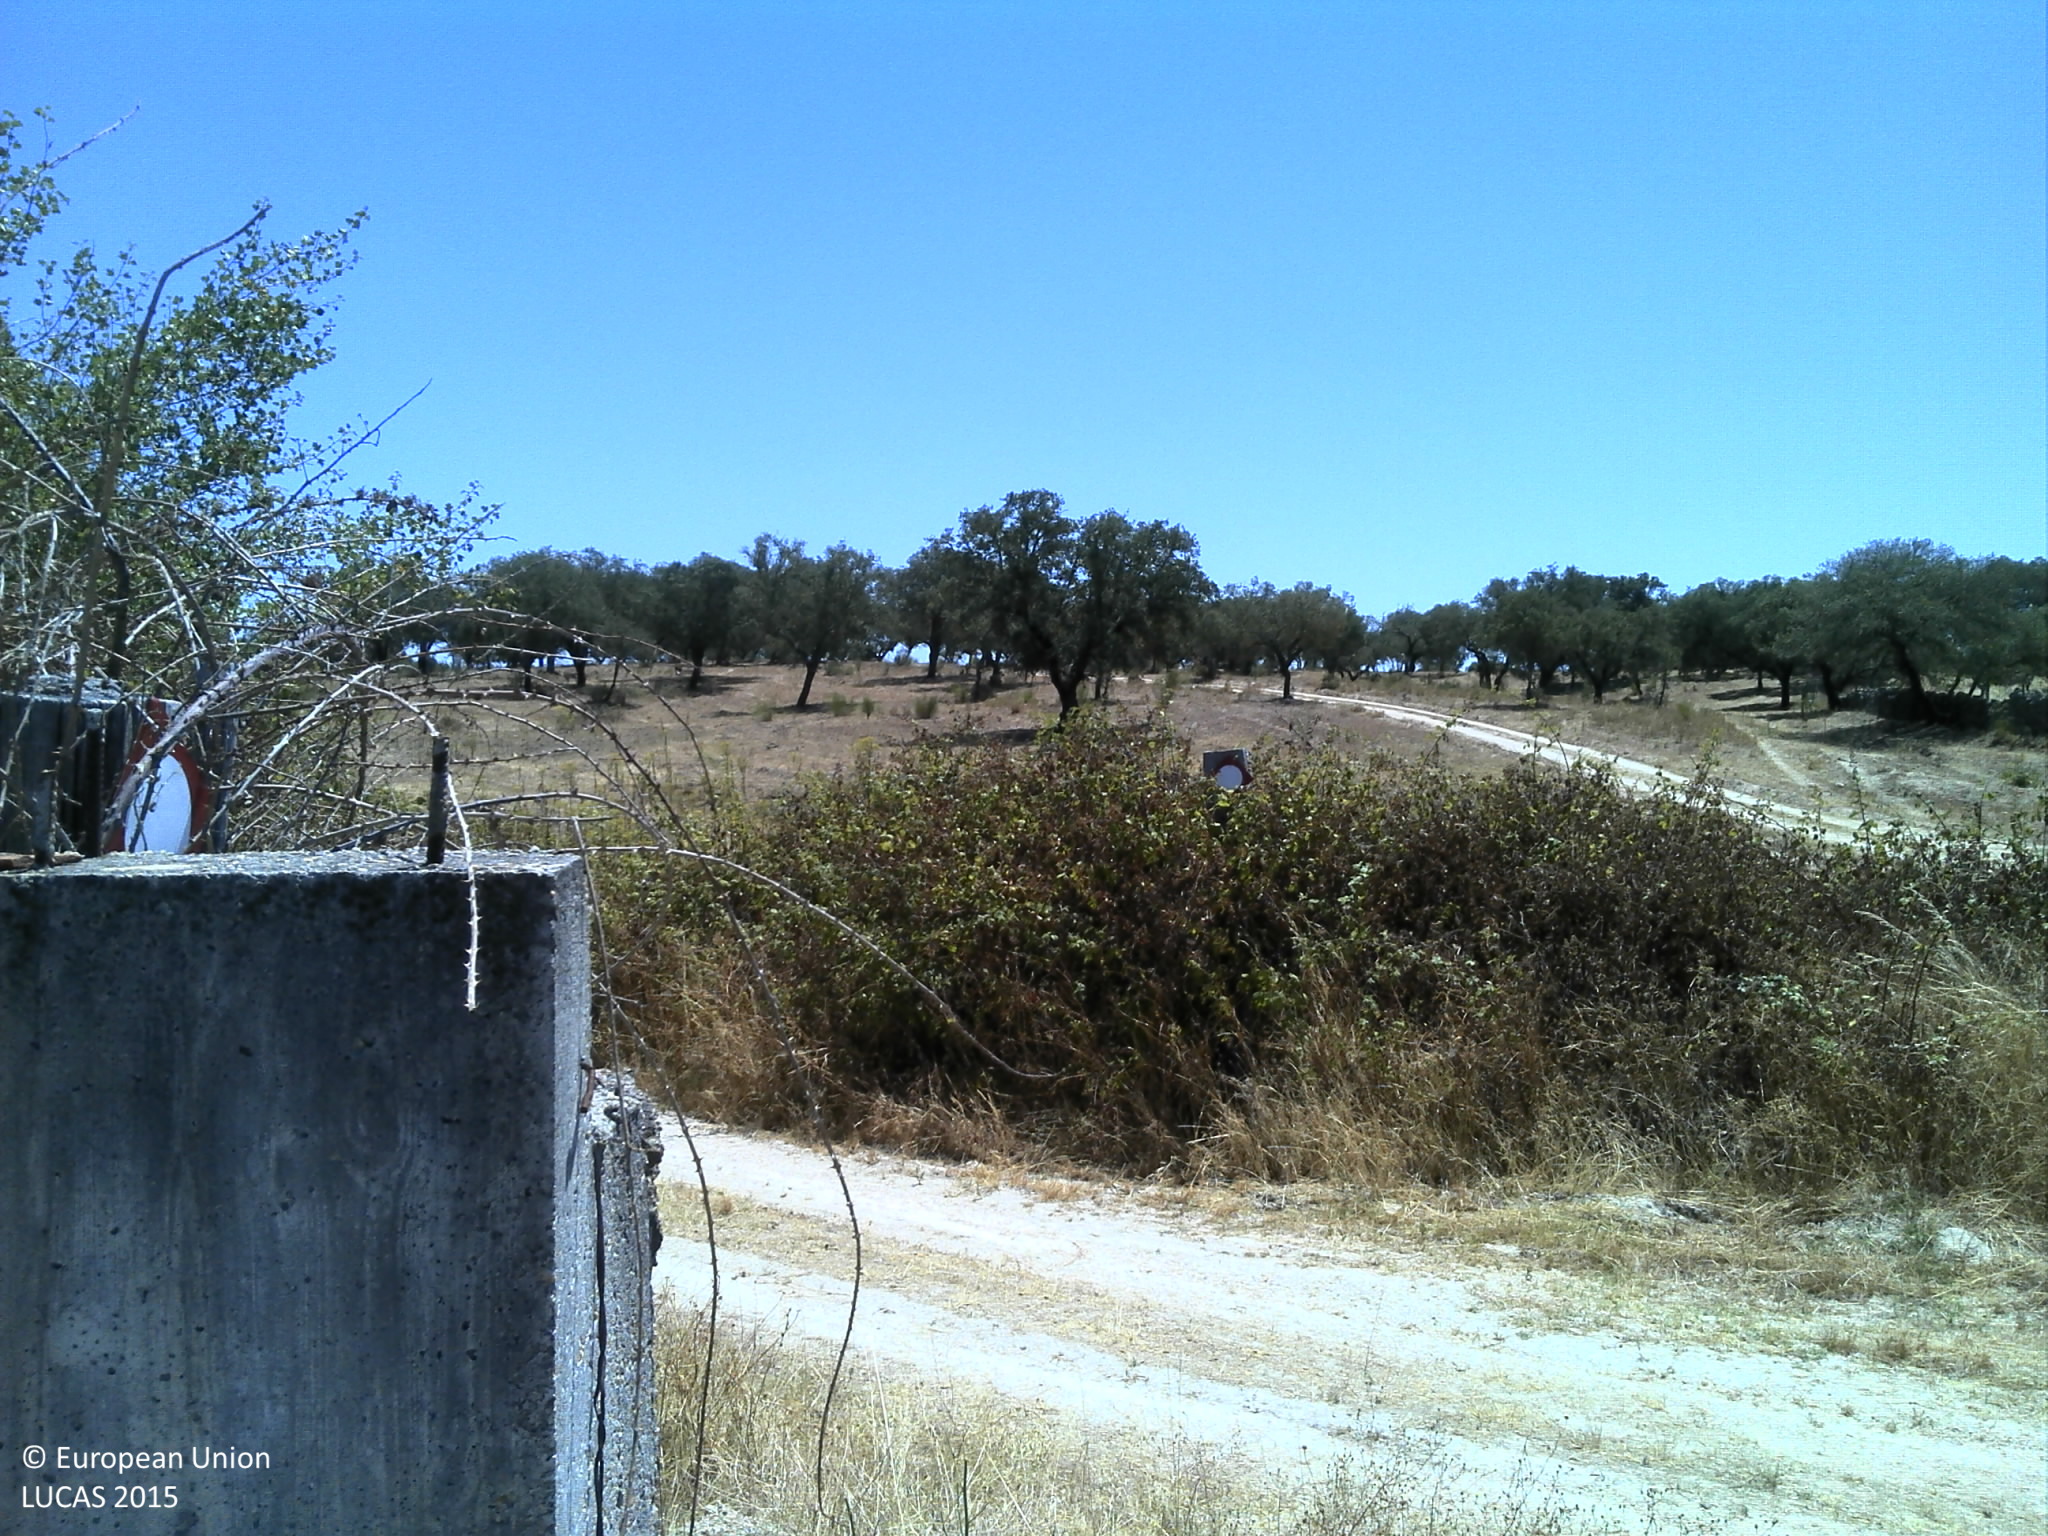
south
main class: Grassland
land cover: Grassland with sparse tree/shrub cover
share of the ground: 10 - 25 %
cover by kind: unconsolidated bare surface 80 %, herbaceous plants 15 %, broadleaved forest trees 5 %
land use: Agriculture (excluding fallow land and kitchen gardens)
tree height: > 5 m
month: July
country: PT
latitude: 39.3241
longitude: -7.7153
